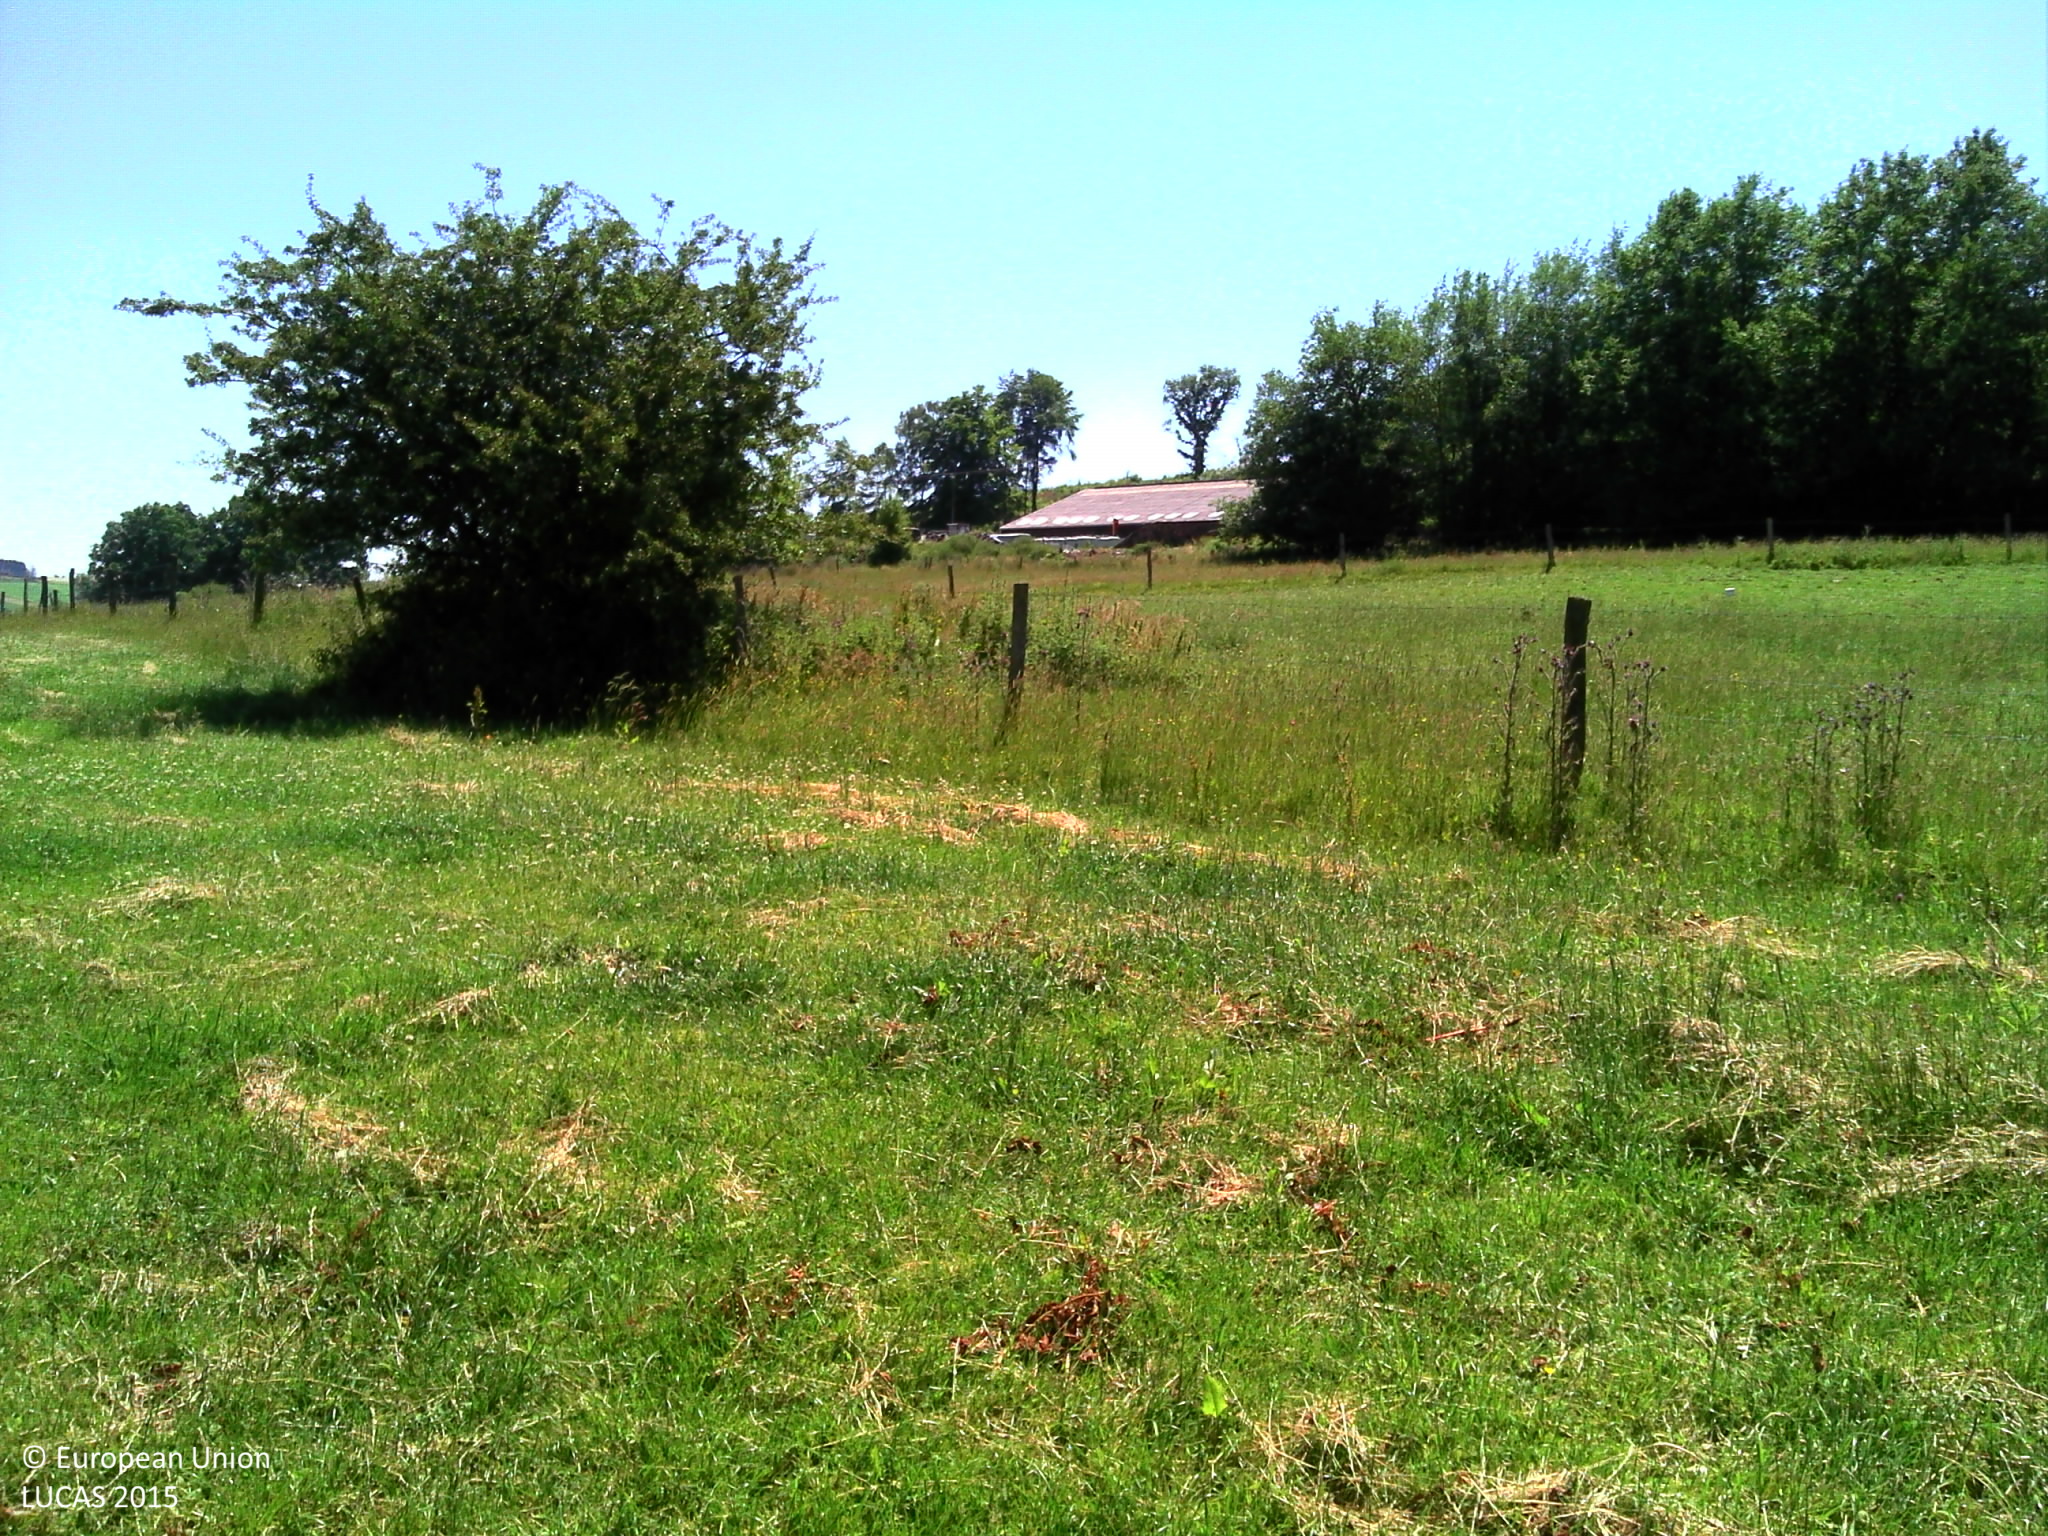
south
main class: Grassland
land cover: Grassland without tree/shrub cover
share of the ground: > 75 %
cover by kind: herbaceous plants 100 %
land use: Agriculture (excluding fallow land and kitchen gardens)
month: June
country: BE
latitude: 50.0421
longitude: 5.5161
